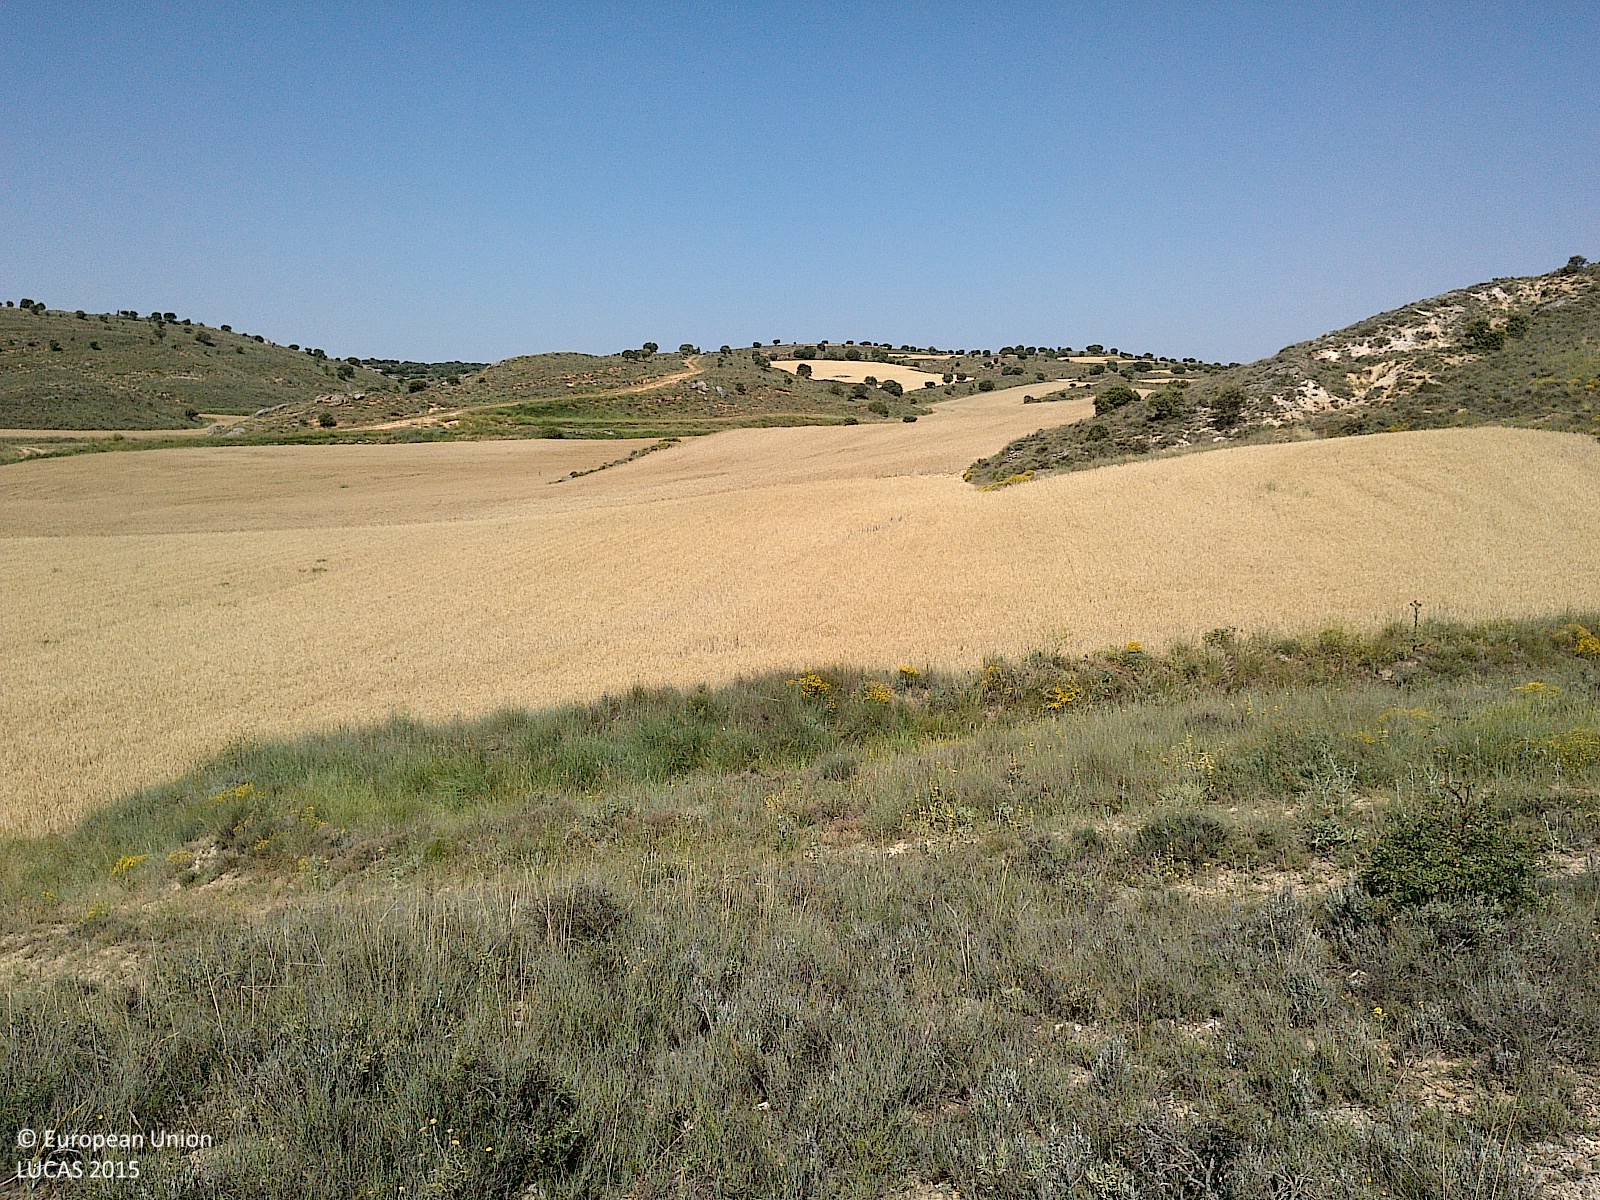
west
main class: Shrubland
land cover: Shrubland without tree cover
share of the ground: > 75 %
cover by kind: shrubs 75 %, unconsolidated bare surface 20 %, consolidated bare surface 5 %
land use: Semi-natural and natural areas not in use
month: July
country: ES
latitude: 41.5365
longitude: -2.1502
